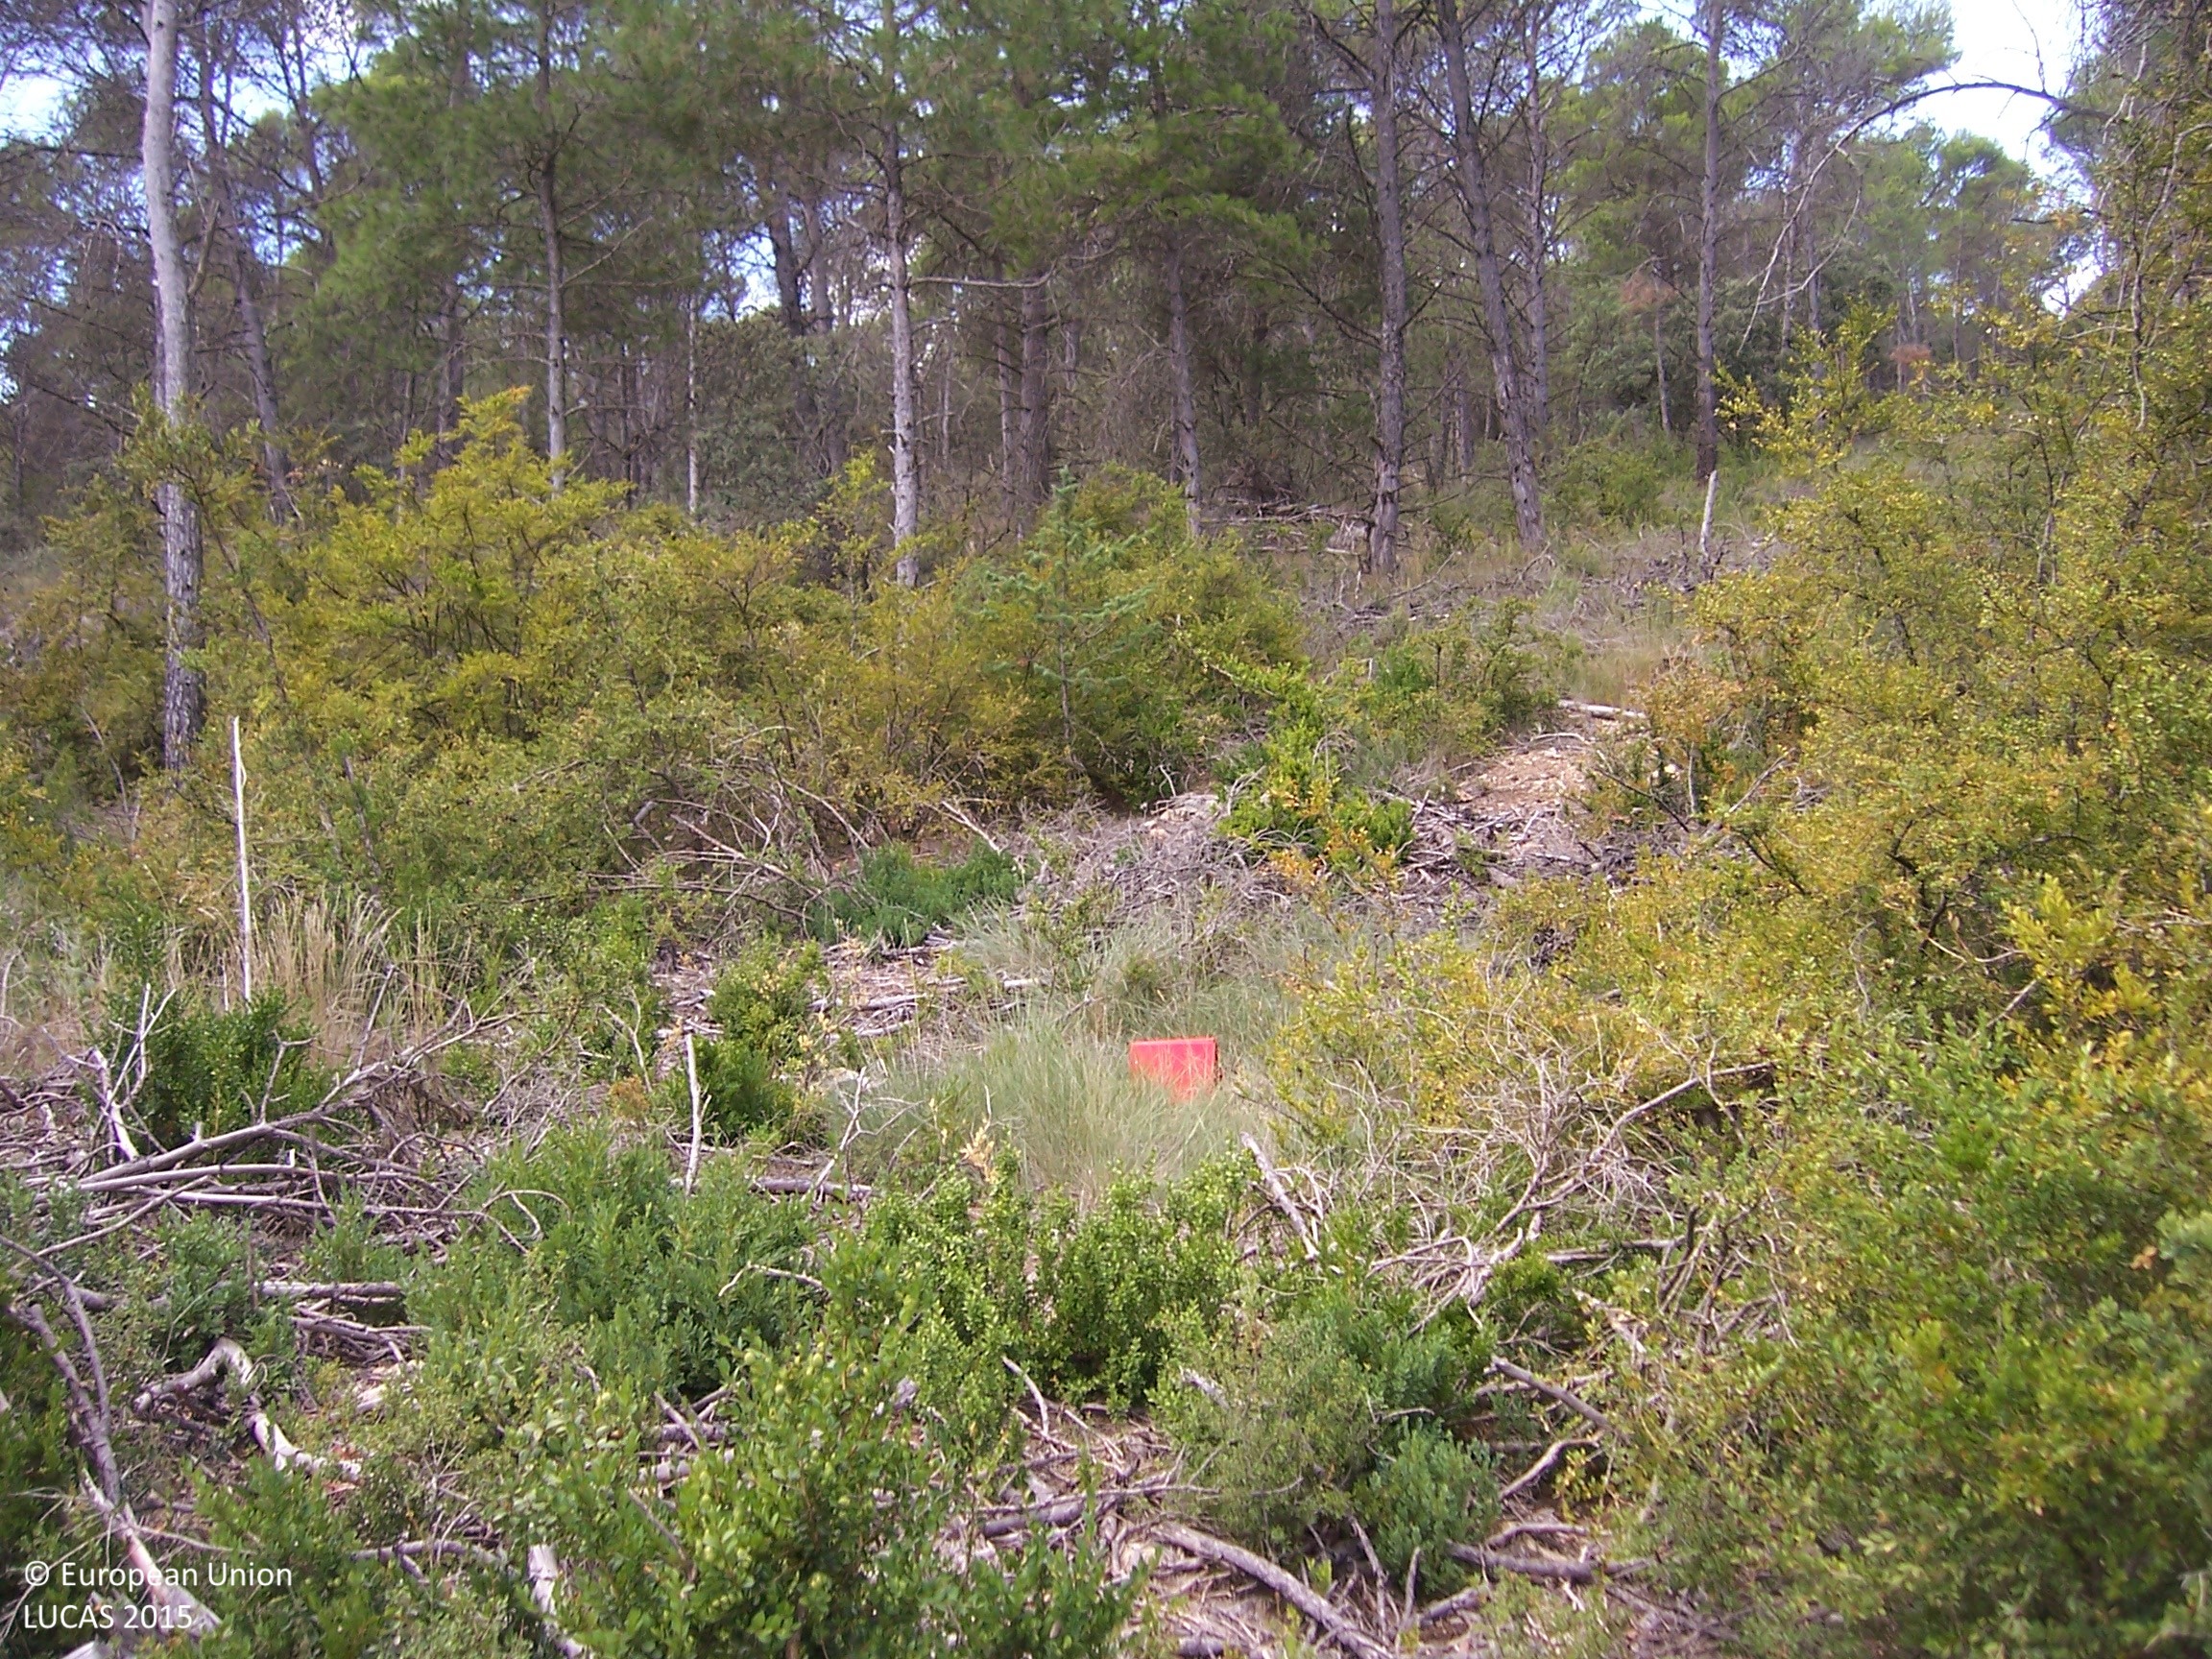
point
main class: Woodland
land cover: Pine dominated coniferous woodland
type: coniferous forest of the mediterranean region
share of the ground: 25 - 50 %
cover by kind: coniferous forest trees 40 %, shrubs 30 %, herbaceous plants 20 %, consolidated bare surface 10 %
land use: Forestry
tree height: > 5 m
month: August
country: ES
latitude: 41.9691
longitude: 0.4876
